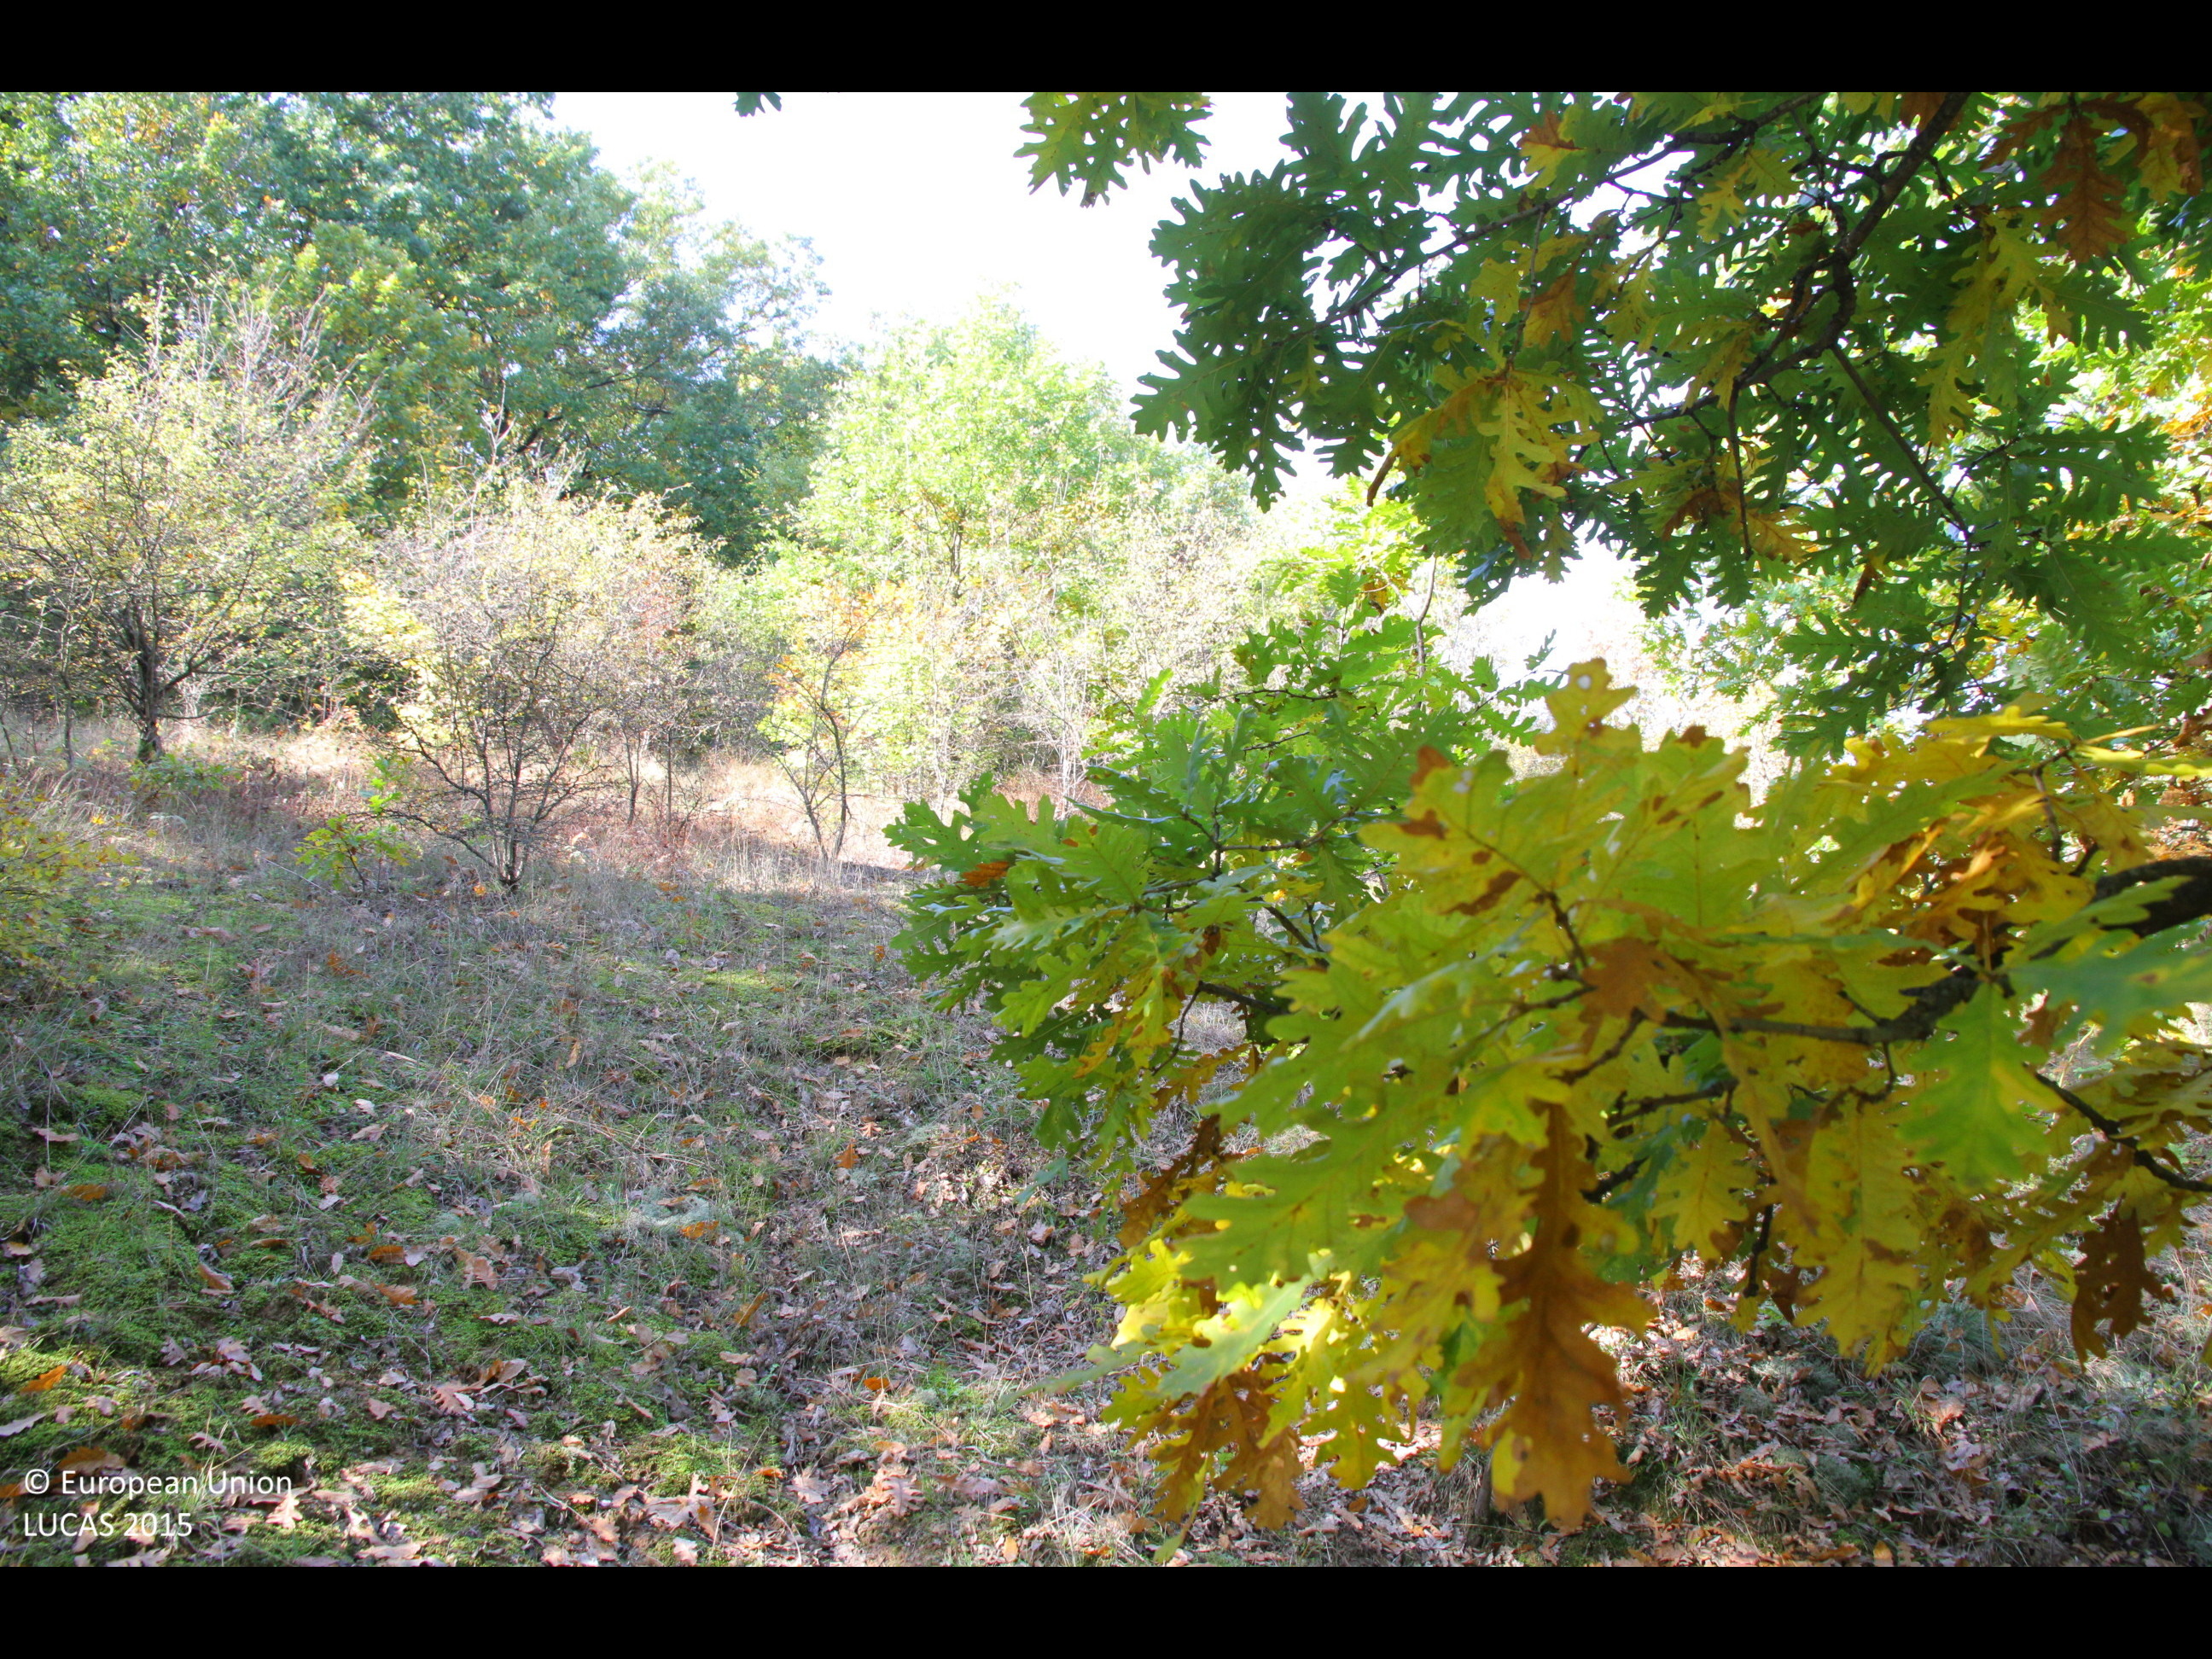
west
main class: Woodland
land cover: Broadleaved woodland
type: mesophytic deciduous forest
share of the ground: > 75 %
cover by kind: broadleaved forest trees 100 %
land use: Forestry
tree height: > 5 m
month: October
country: BG
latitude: 42.9986
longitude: 26.9517
